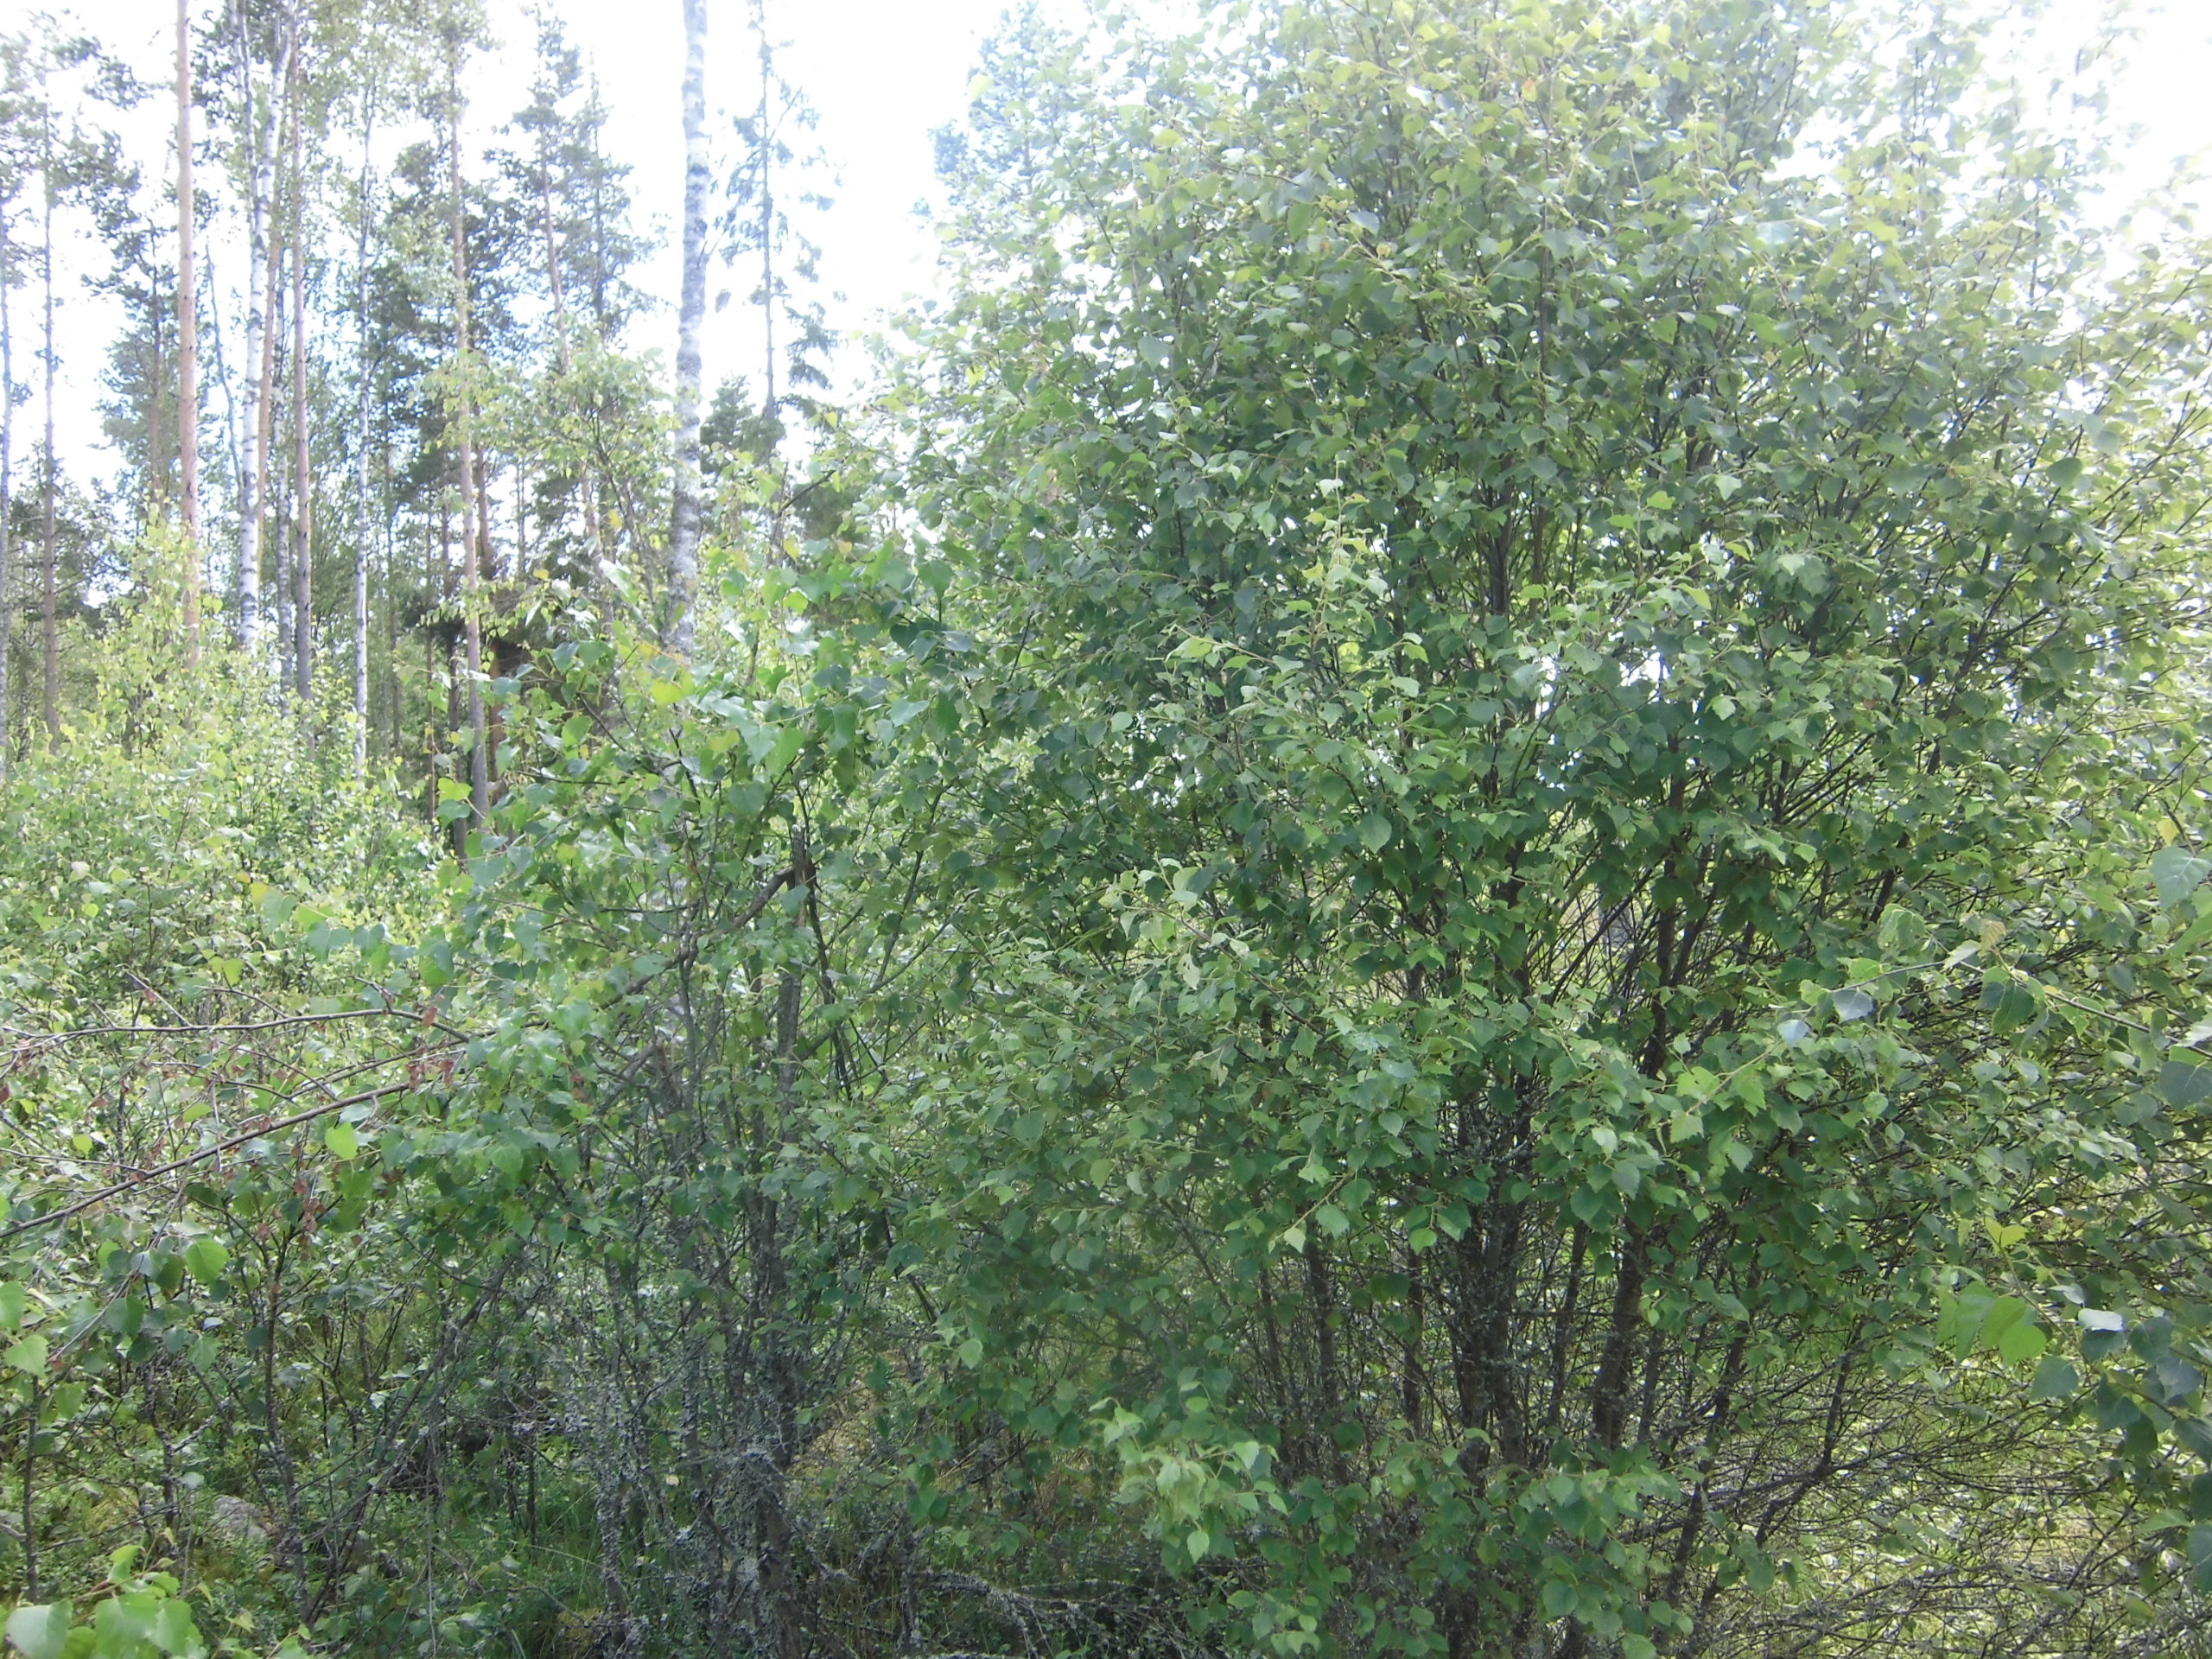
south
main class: Woodland
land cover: Broadleaved woodland
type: boreal forest
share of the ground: 50 - 75 %
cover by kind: broadleaved forest trees 55 %, herbaceous plants 20 %, shrubs 10 %, lichens and mosses 10 %, coniferous forest trees 5 %
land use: Forestry
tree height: > 5 m
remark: Clear cut
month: July
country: SE
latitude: 57.2092
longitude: 15.4110
